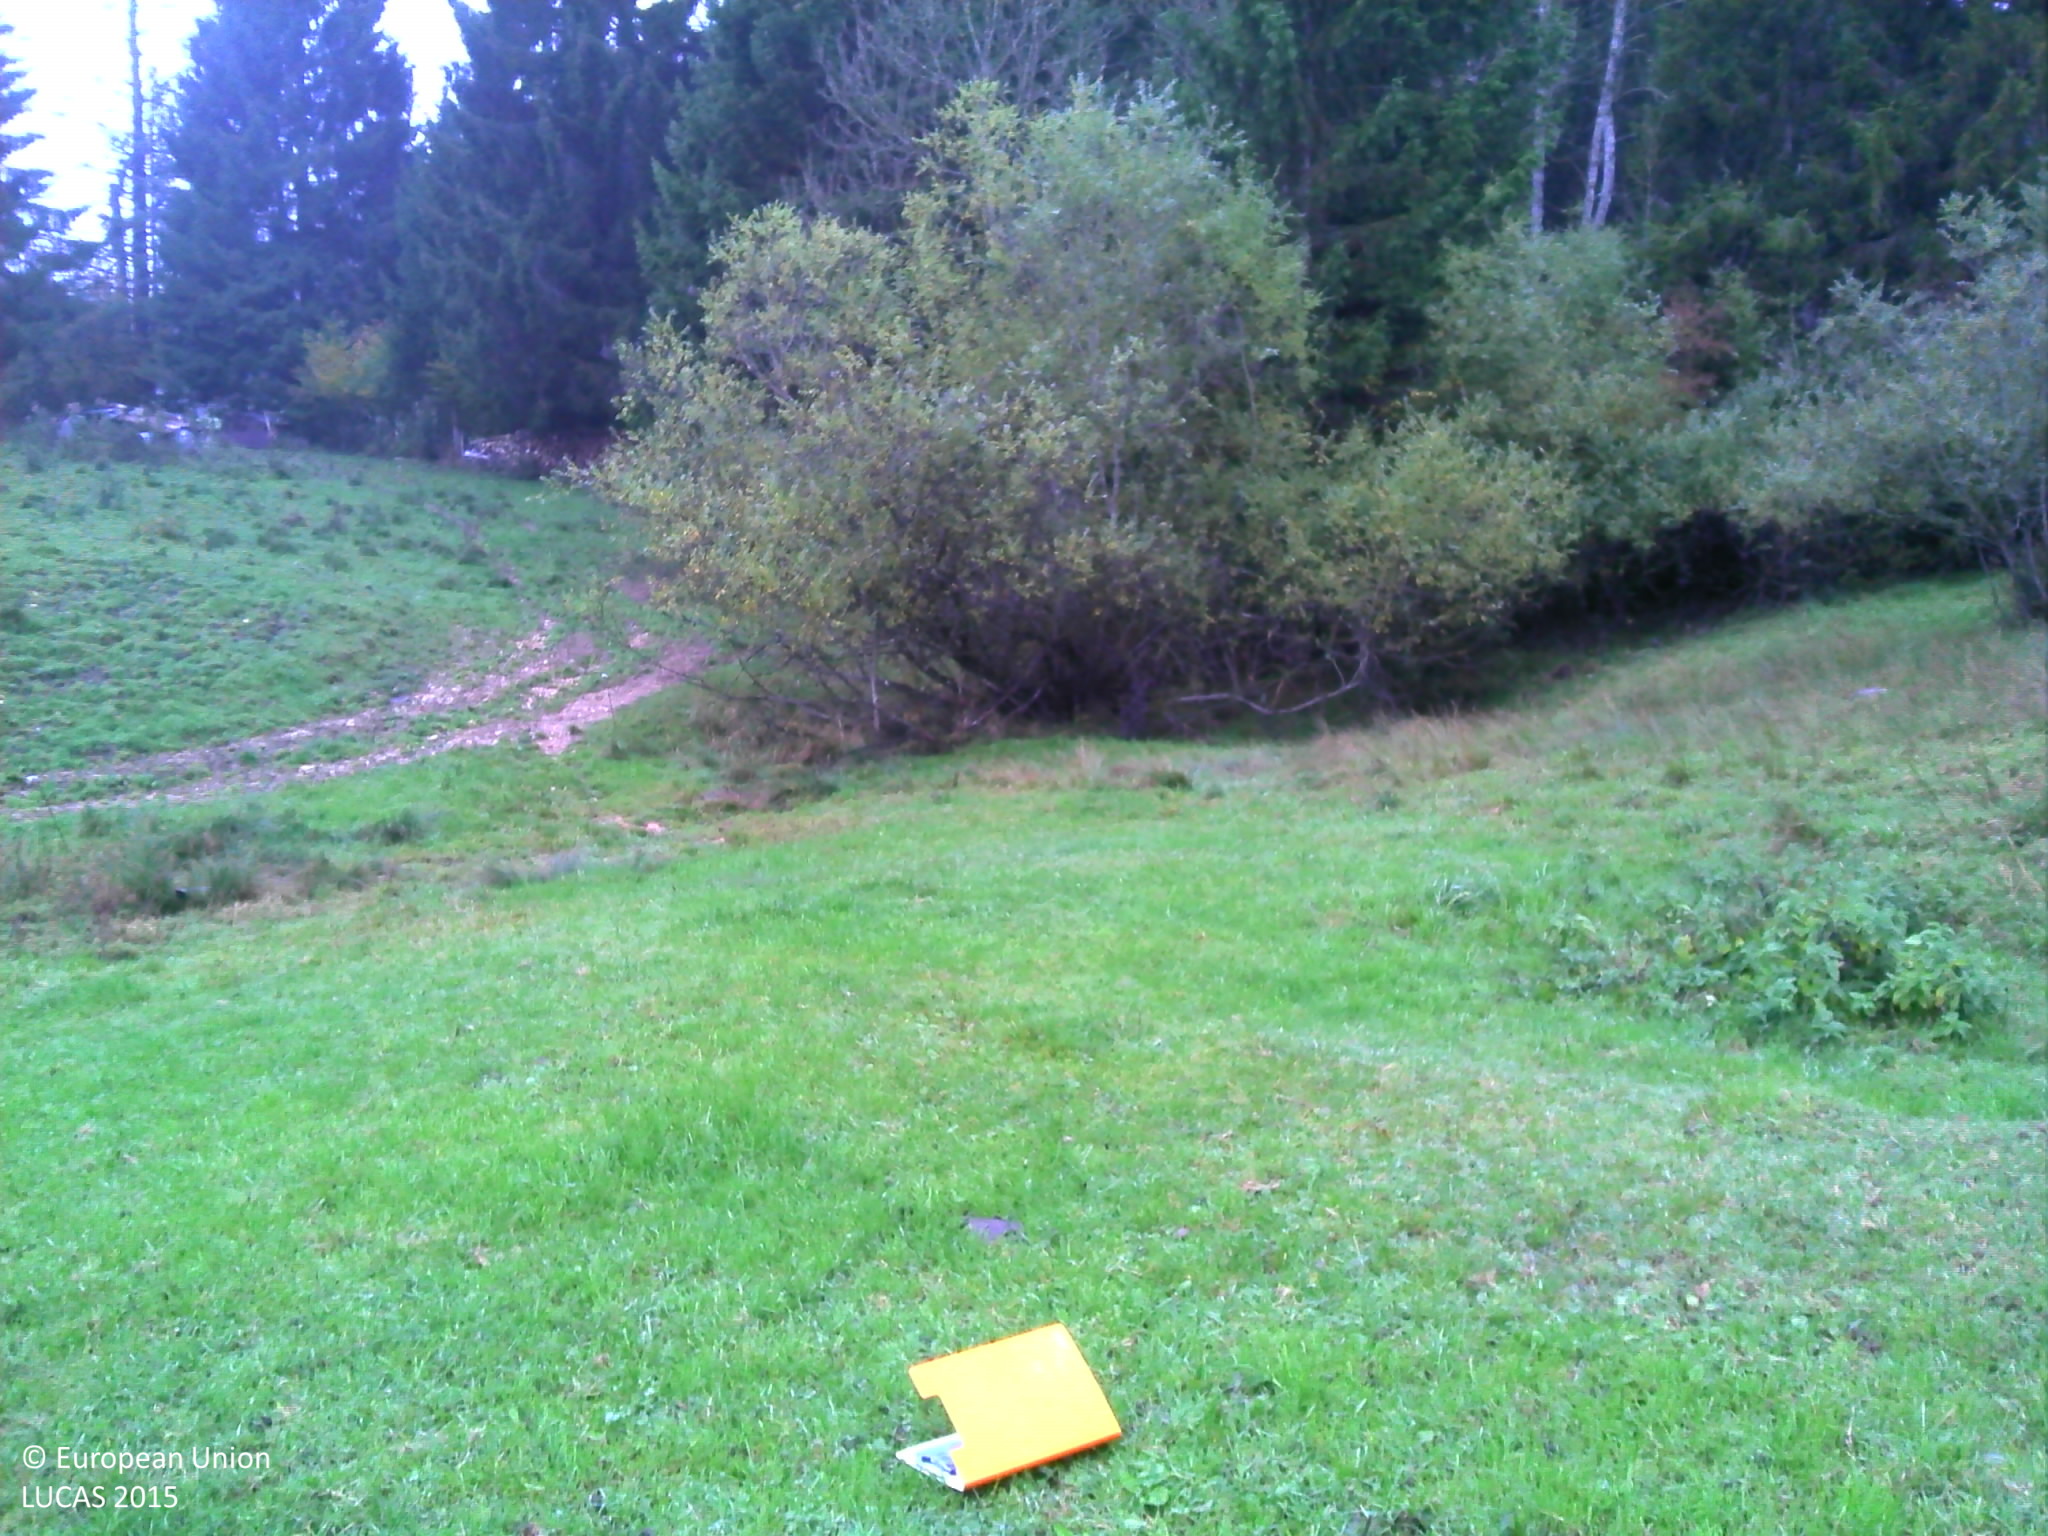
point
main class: Grassland
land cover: Grassland without tree/shrub cover
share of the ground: > 75 %
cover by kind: herbaceous plants 100 %
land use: Agriculture (excluding fallow land and kitchen gardens)
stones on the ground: < 10 %
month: October
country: FR
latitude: 46.8098
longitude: 6.2939
